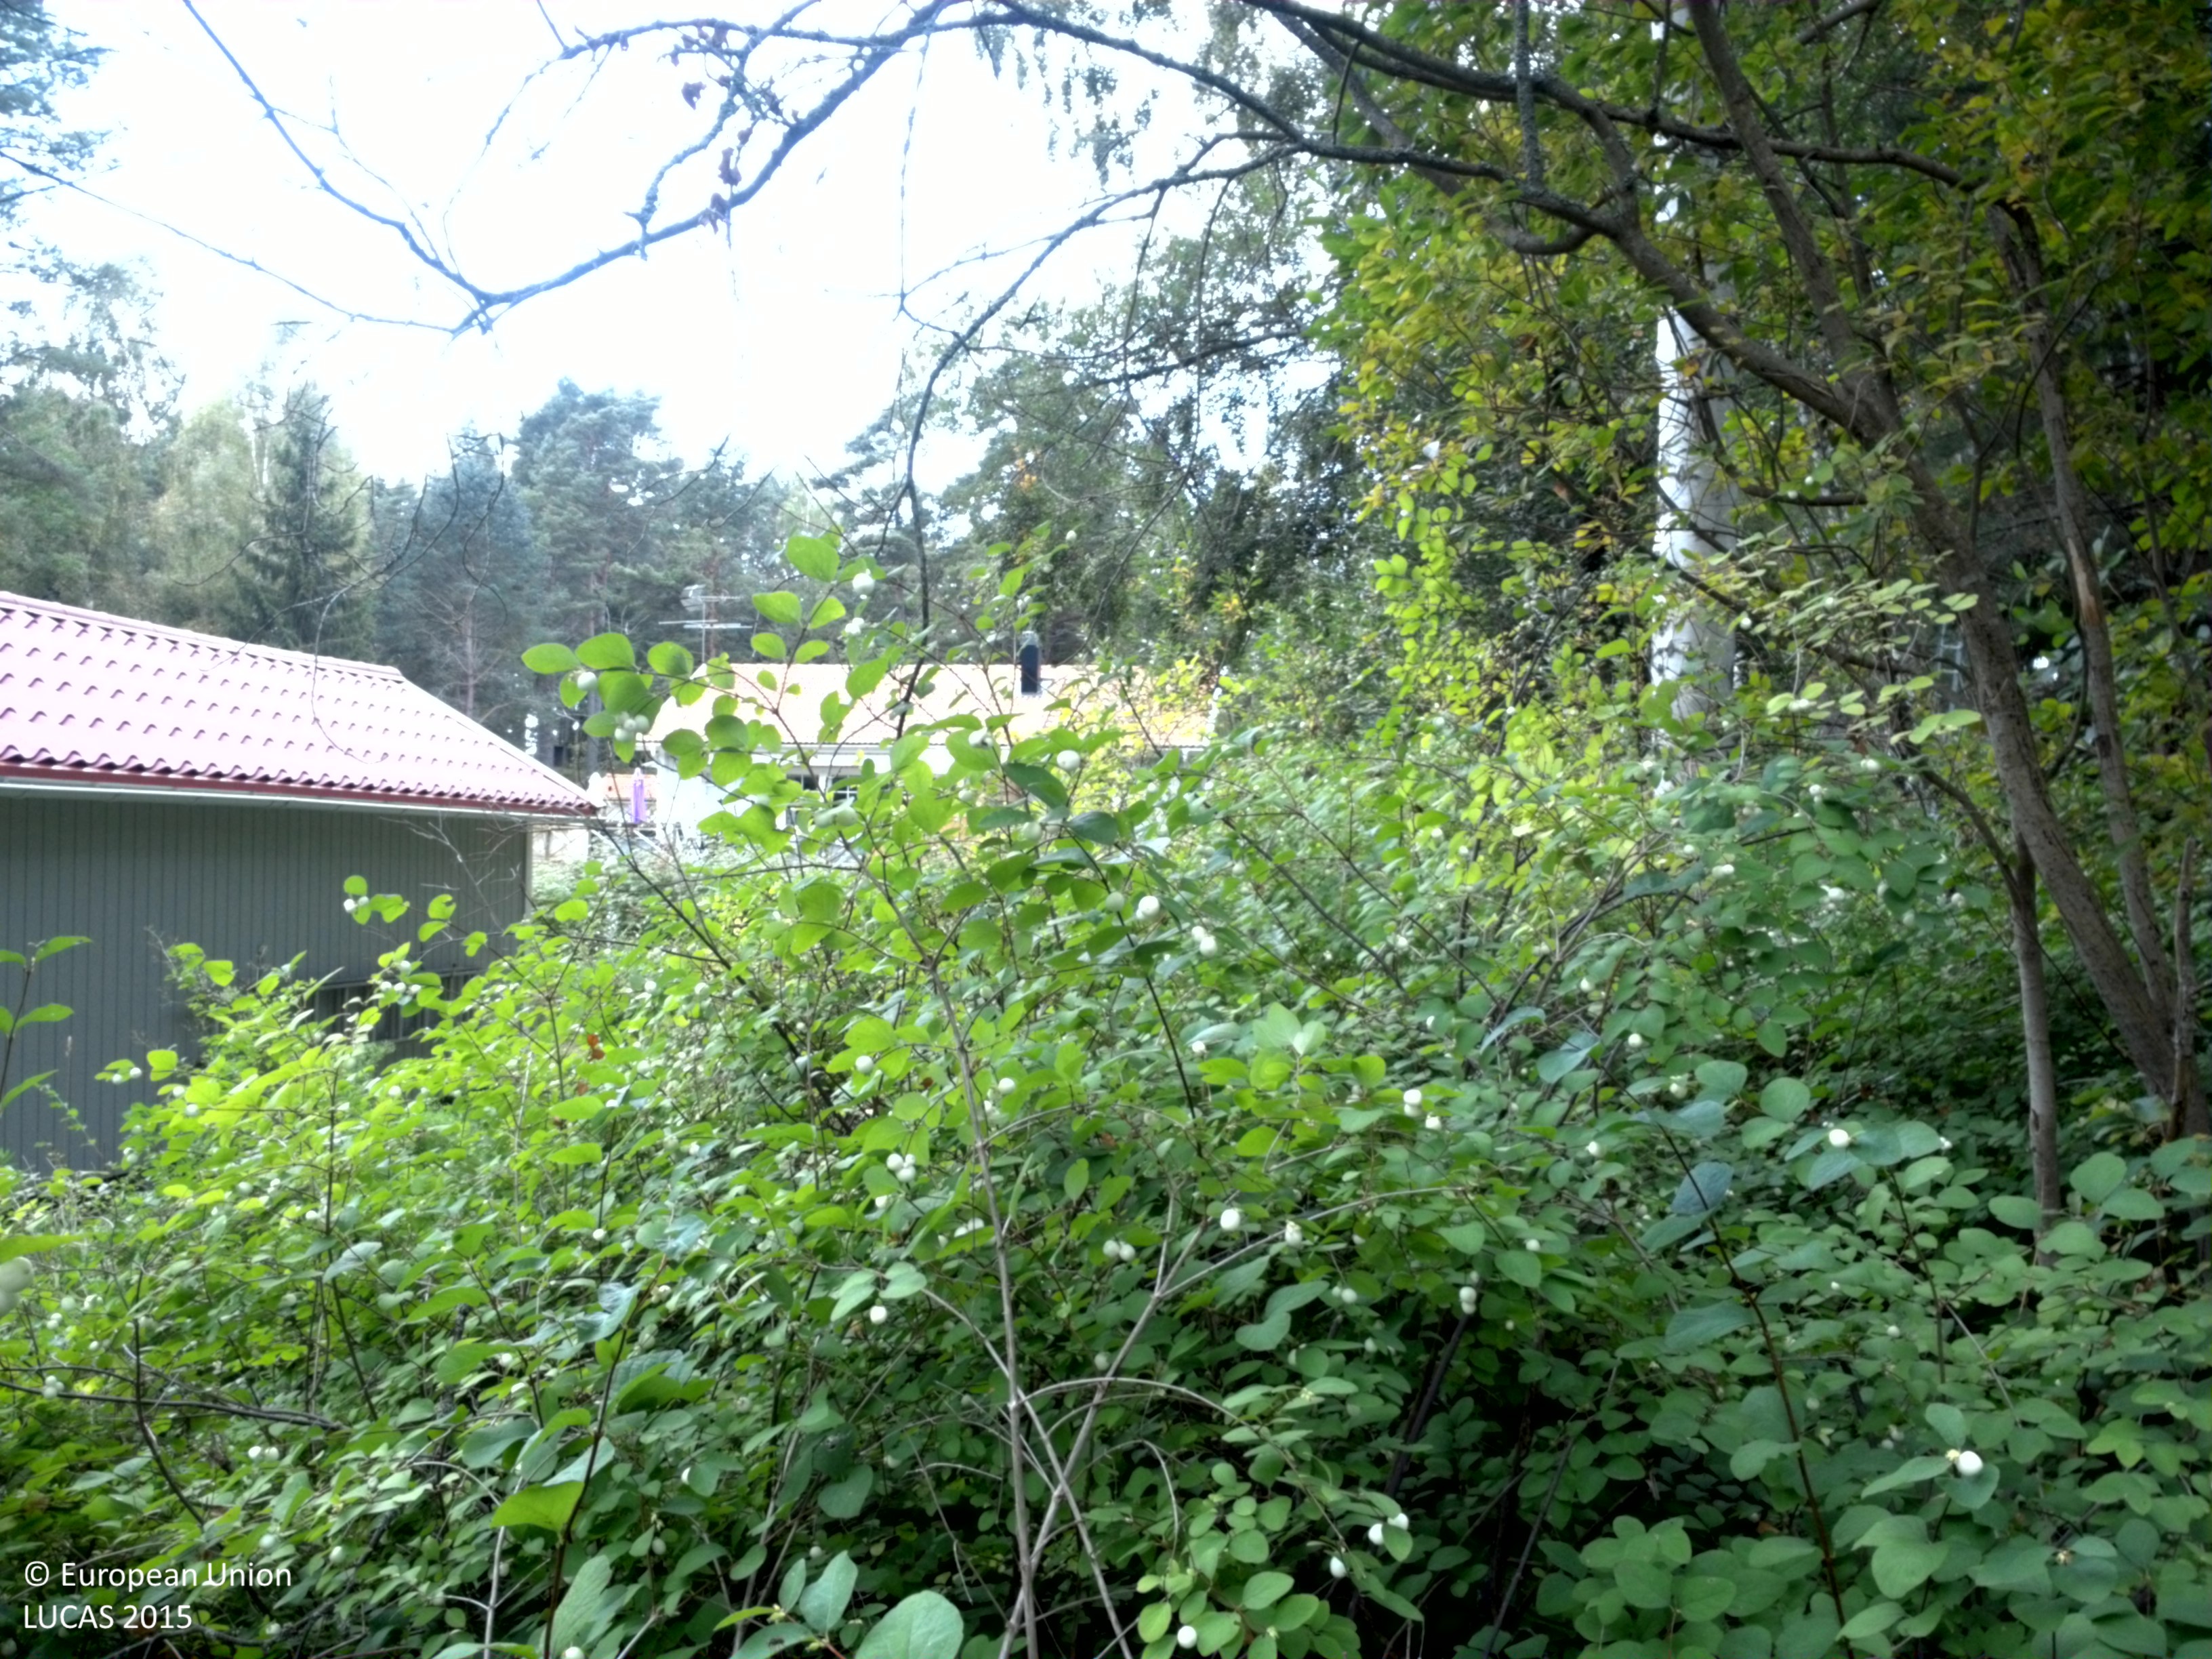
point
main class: Woodland
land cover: Broadleaved woodland
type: boreal forest
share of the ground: 50 - 75 %
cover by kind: broadleaved forest trees 65 %, shrubs 20 %, coniferous forest trees 10 %, herbaceous plants 5 %
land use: Amenities, museums, leisure
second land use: Residential
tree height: > 5 m
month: September
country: SE
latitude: 59.2376
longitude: 18.4674
